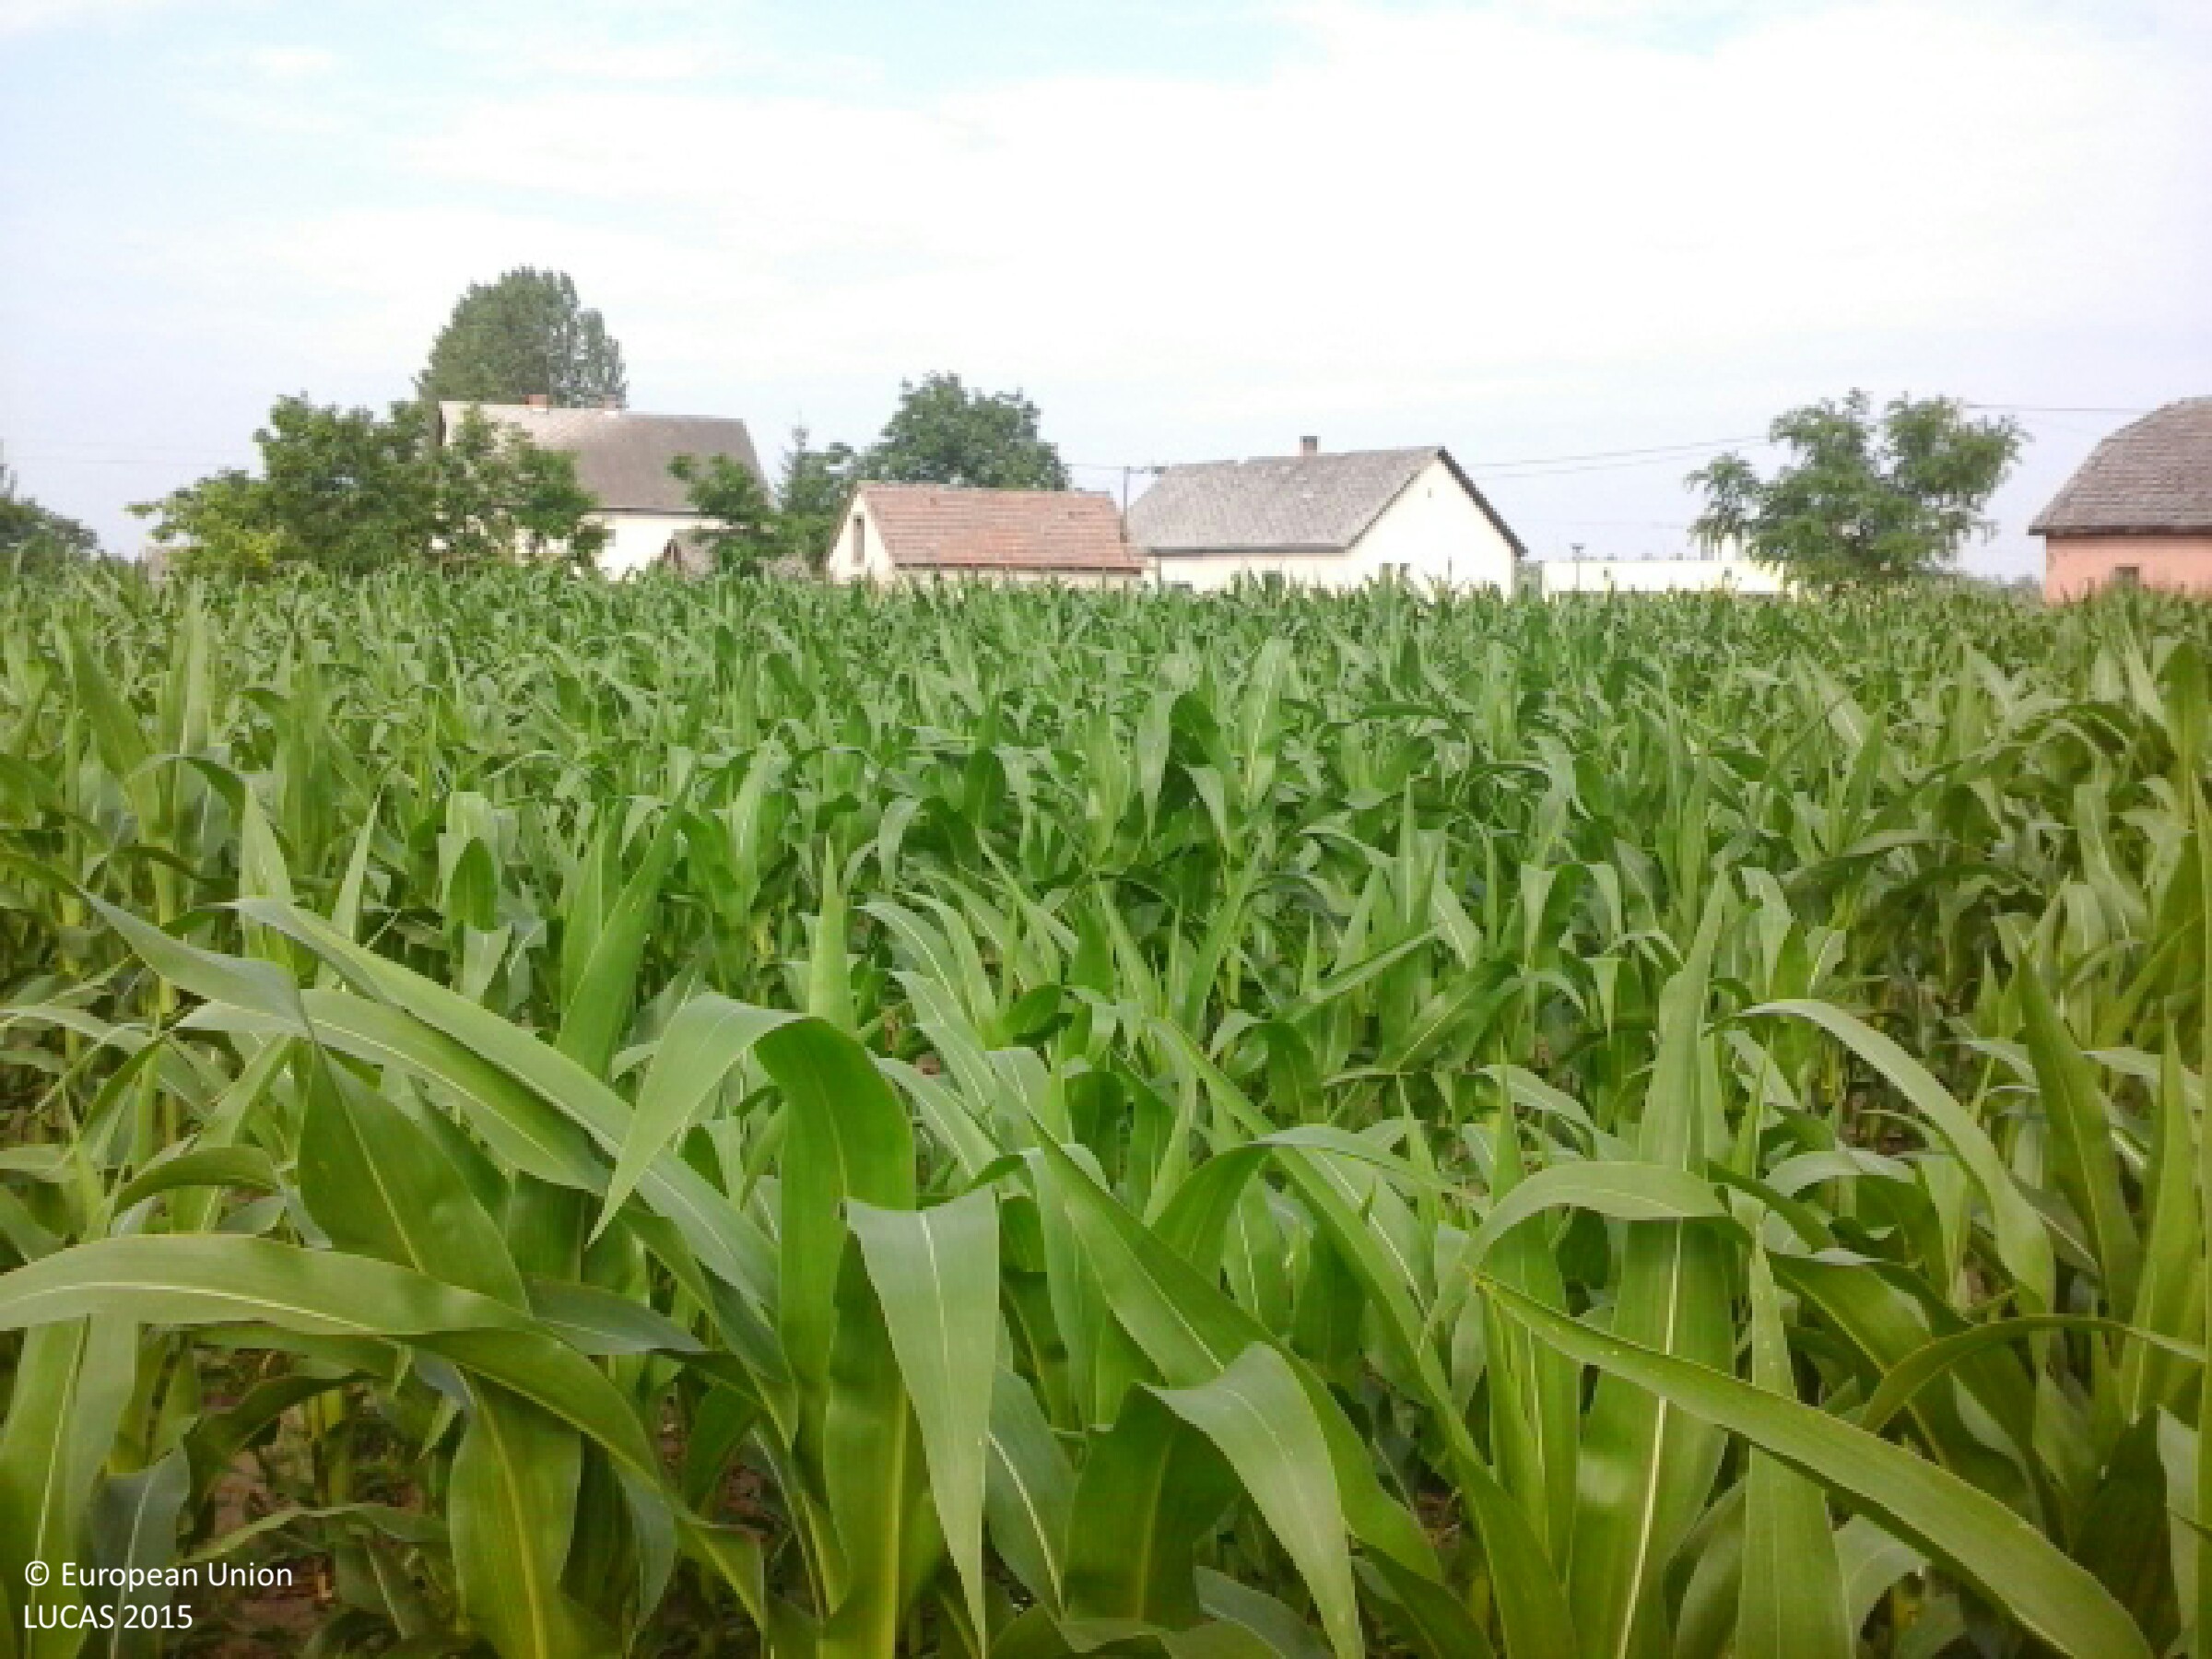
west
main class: Cropland
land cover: Maize
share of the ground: > 75 %
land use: Agriculture (excluding fallow land and kitchen gardens)
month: June
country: HU
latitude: 48.1089
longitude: 22.0196
